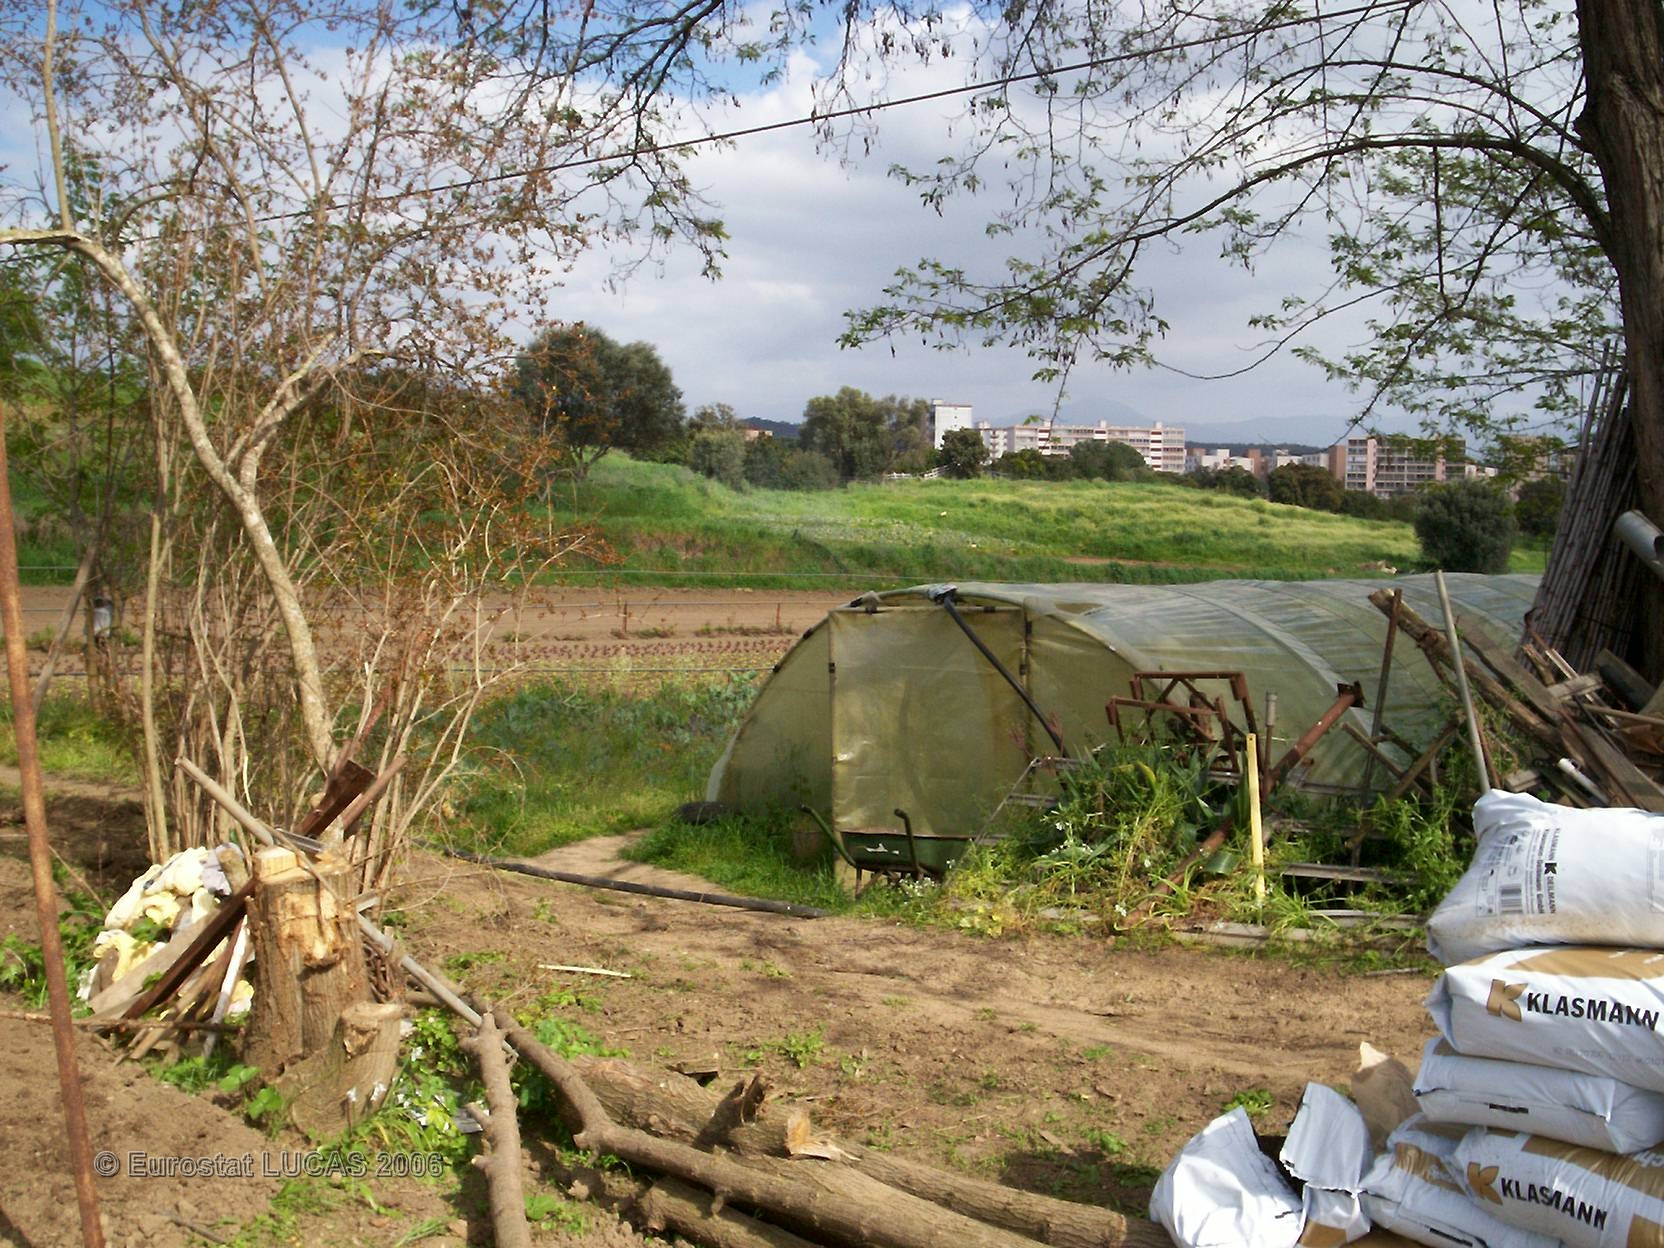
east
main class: Cropland
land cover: Tomatoes
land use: Agriculture (excluding fallow land and kitchen gardens)
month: April
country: FR
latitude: 41.9415
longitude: 8.7384
